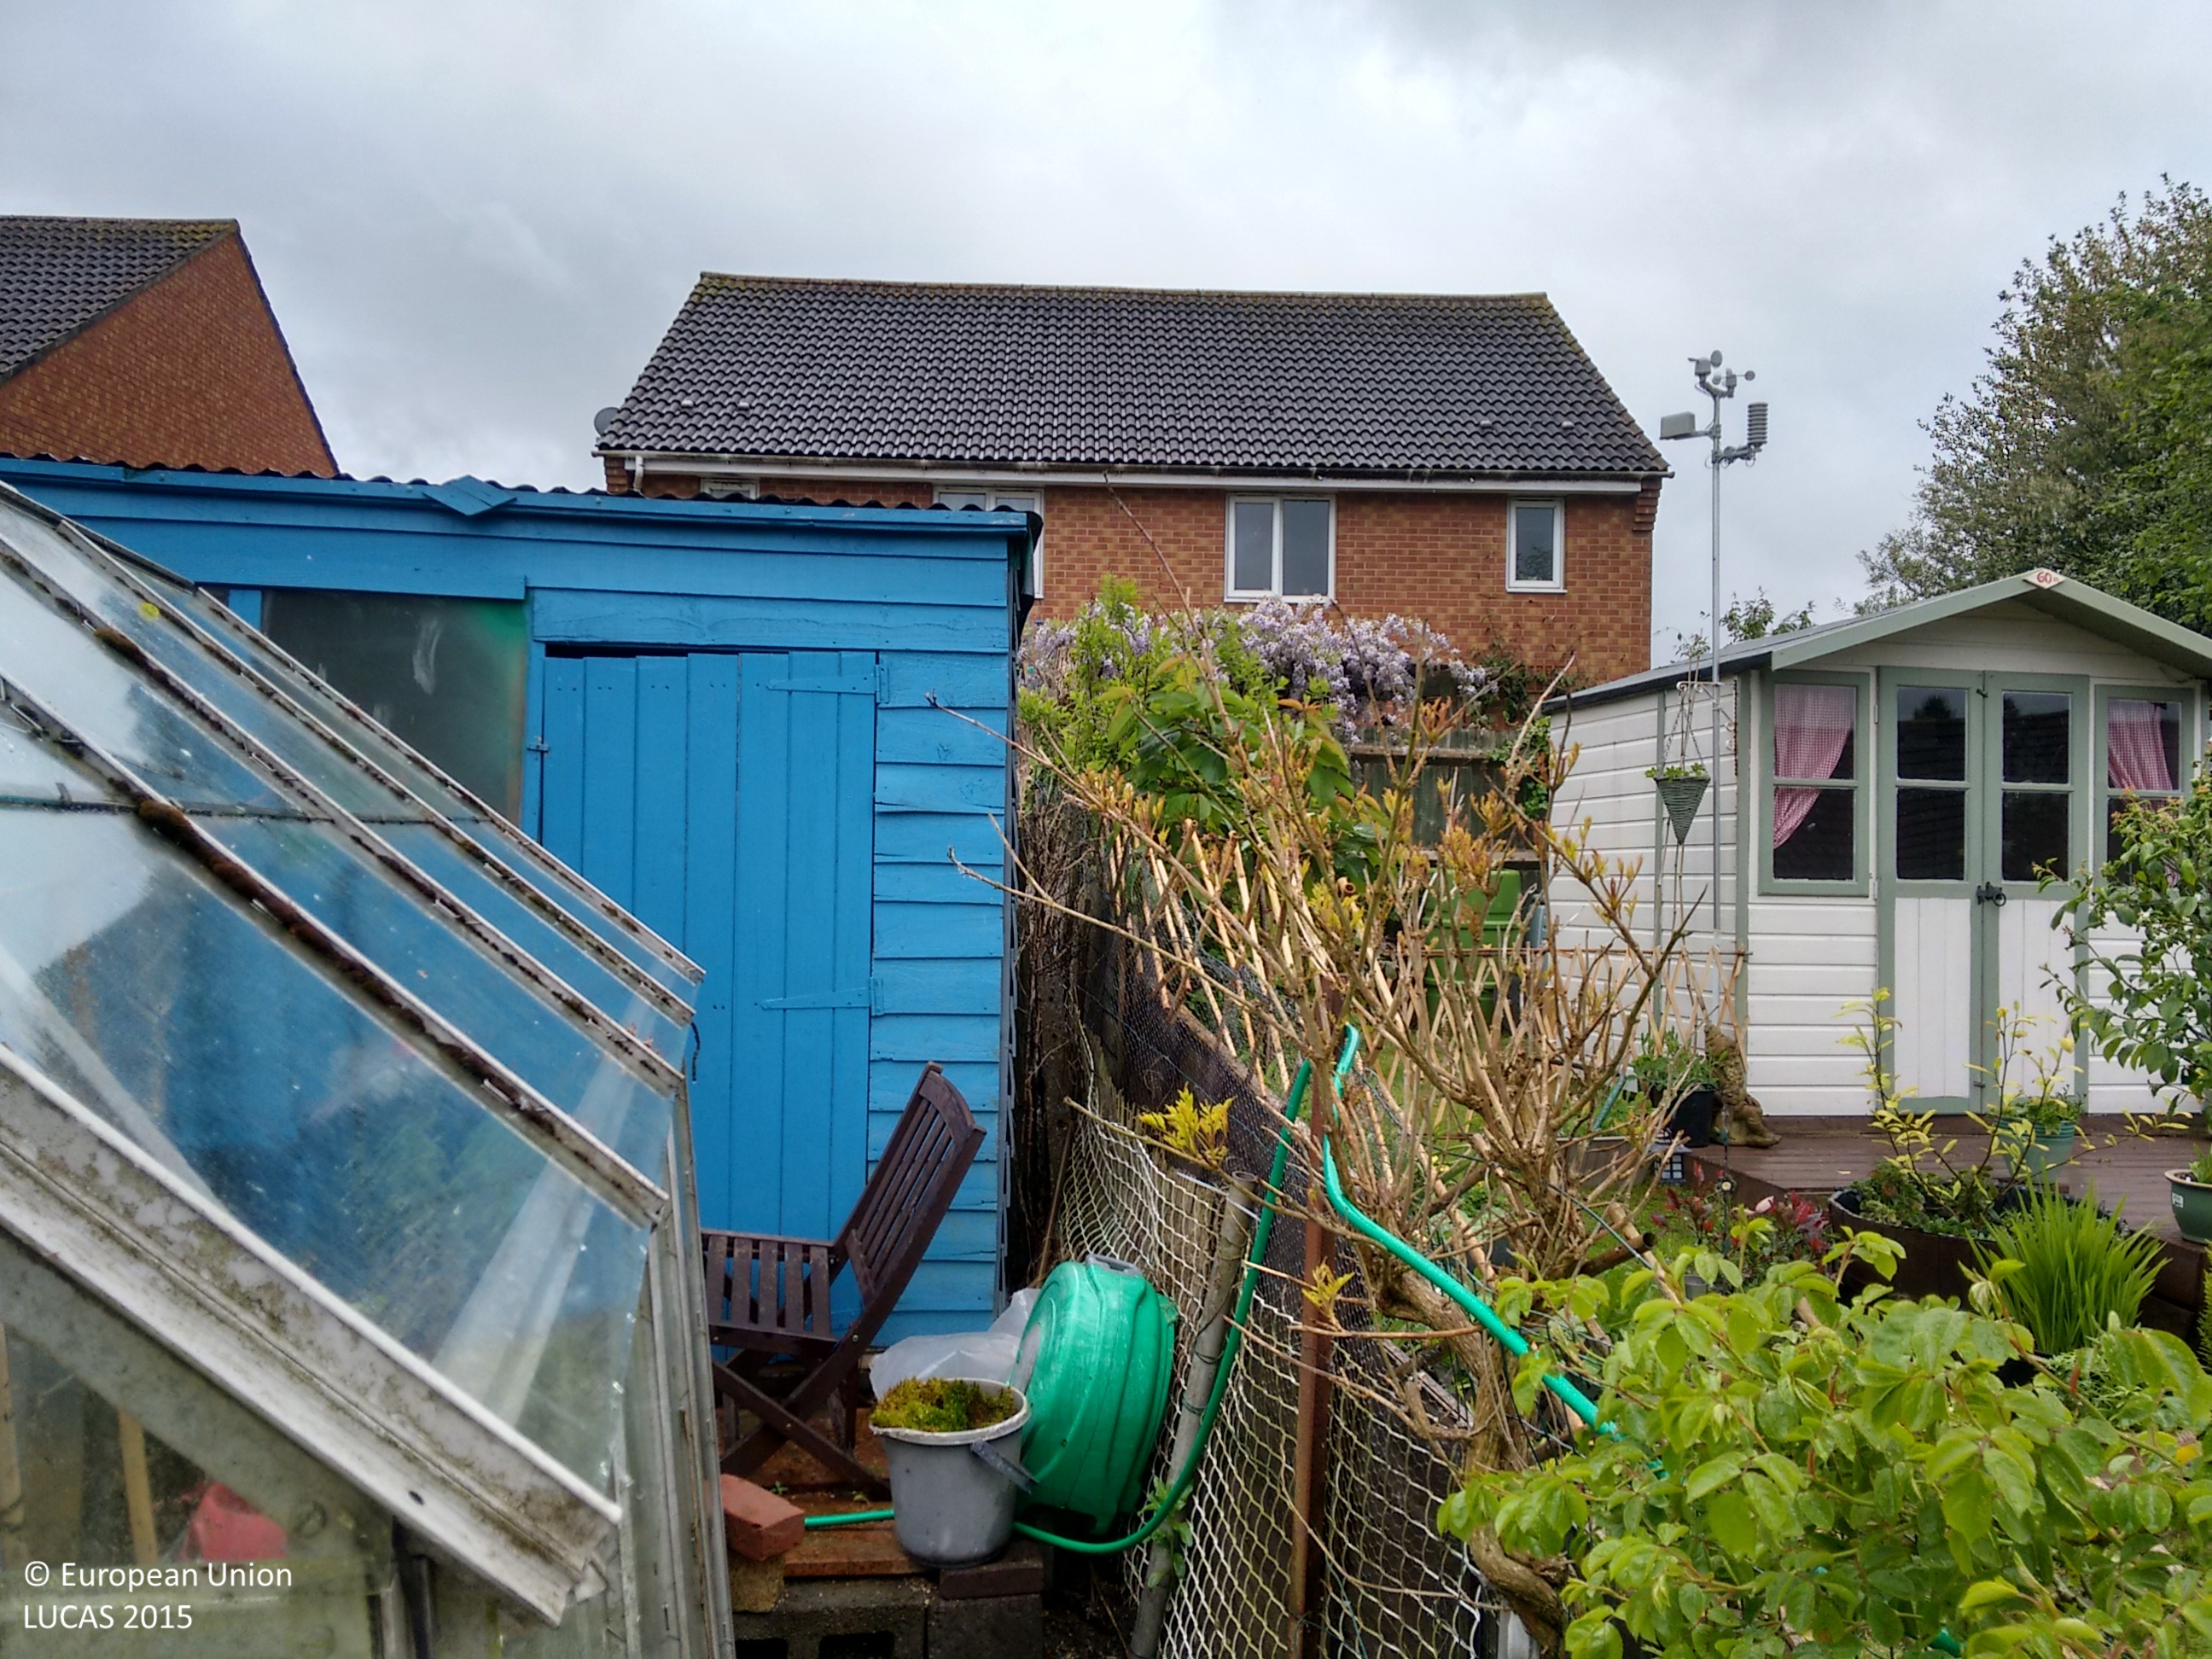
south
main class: Grassland
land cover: Grassland without tree/shrub cover
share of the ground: > 75 %
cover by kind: herbaceous plants 85 %, consolidated bare surface 10 %, shrubs 5 %
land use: Residential
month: May
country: GB
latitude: 50.9987
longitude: -0.9444
